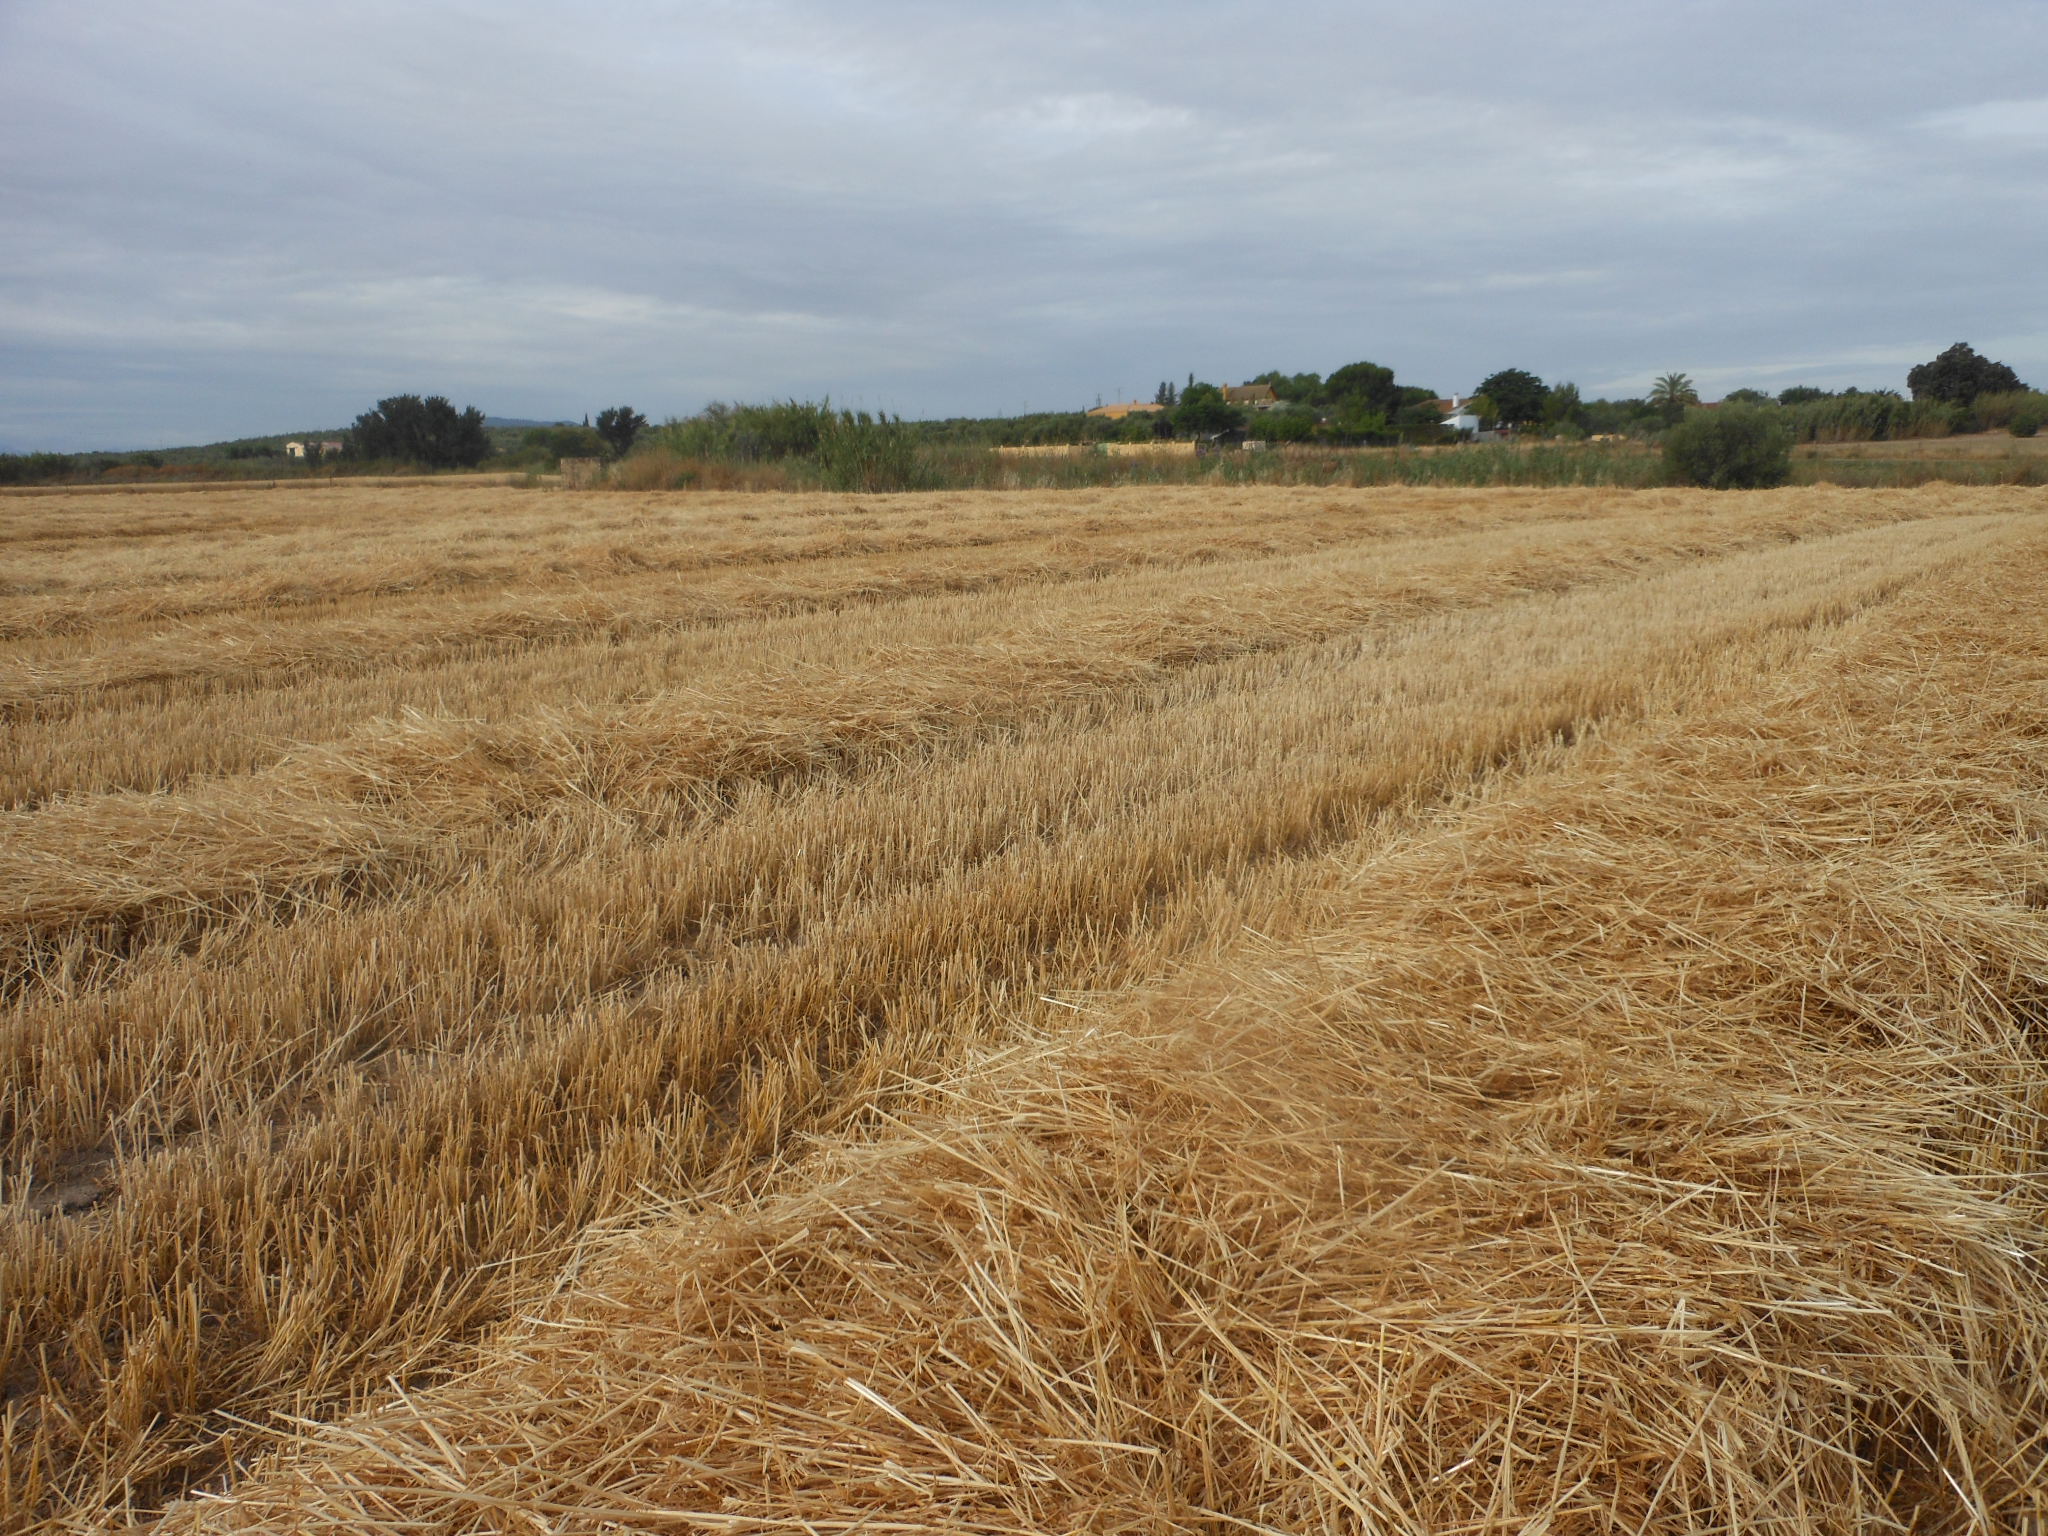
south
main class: Cropland
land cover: Common wheat
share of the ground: < 10 %
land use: Agriculture (excluding fallow land and kitchen gardens)
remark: Harvested field
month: June
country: ES
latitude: 37.1939
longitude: -5.4570
